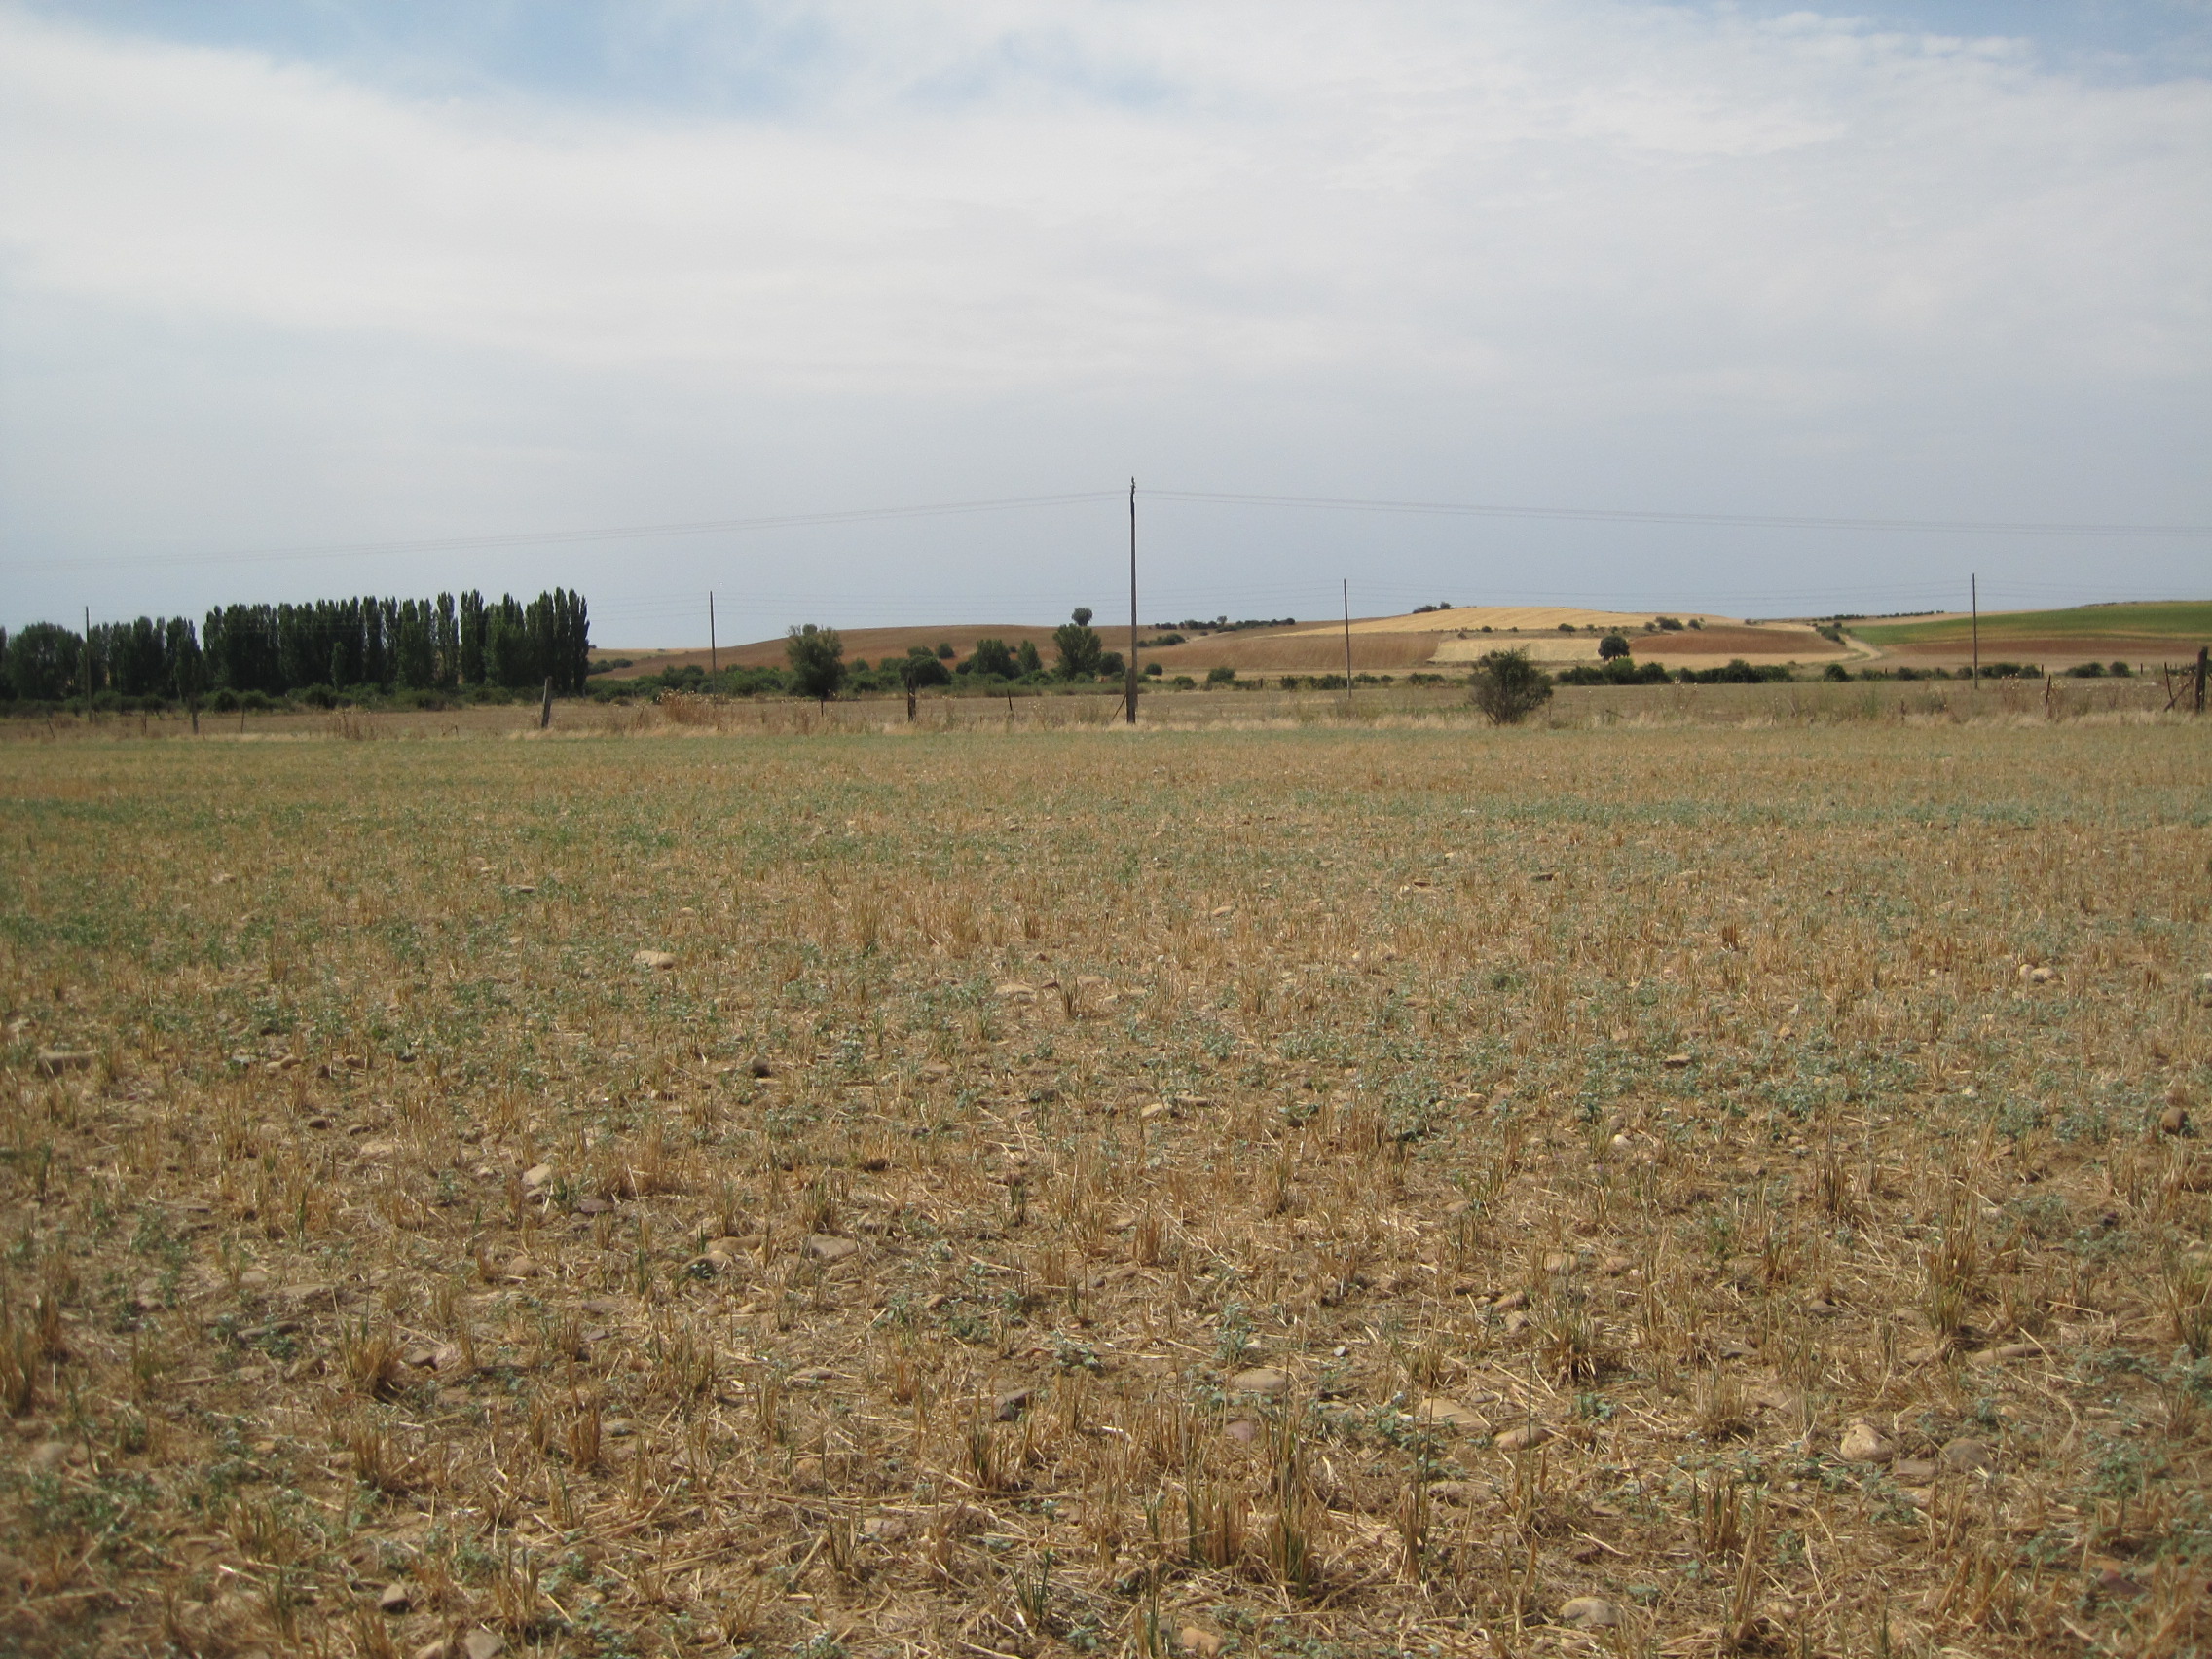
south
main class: Cropland
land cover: Common wheat
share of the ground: < 10 %
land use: Agriculture (excluding fallow land and kitchen gardens)
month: July
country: ES
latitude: 41.7302
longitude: -5.4846
